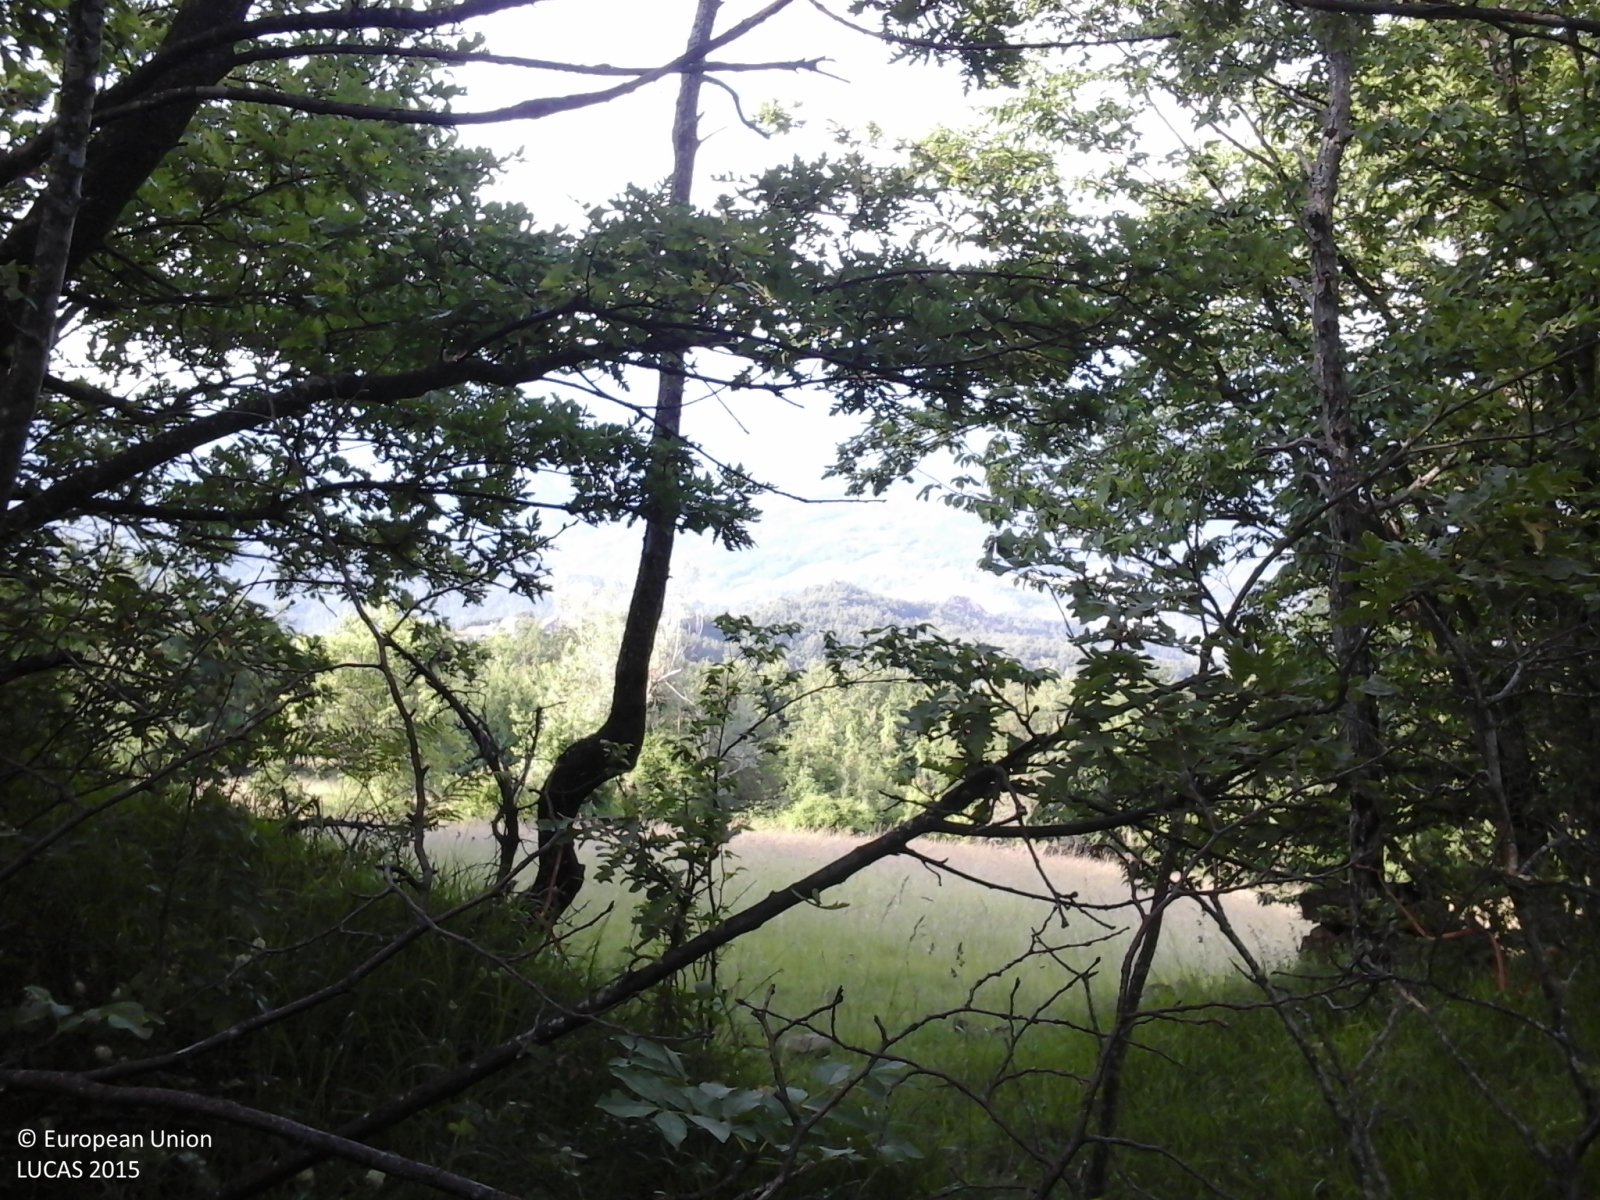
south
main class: Woodland
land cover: Broadleaved woodland
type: thermophilous deciduous forest
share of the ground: > 75 %
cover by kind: broadleaved forest trees 100 %
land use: Forestry
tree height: > 5 m
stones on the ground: < 10 %
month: June
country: IT
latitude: 44.6924
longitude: 9.5845
